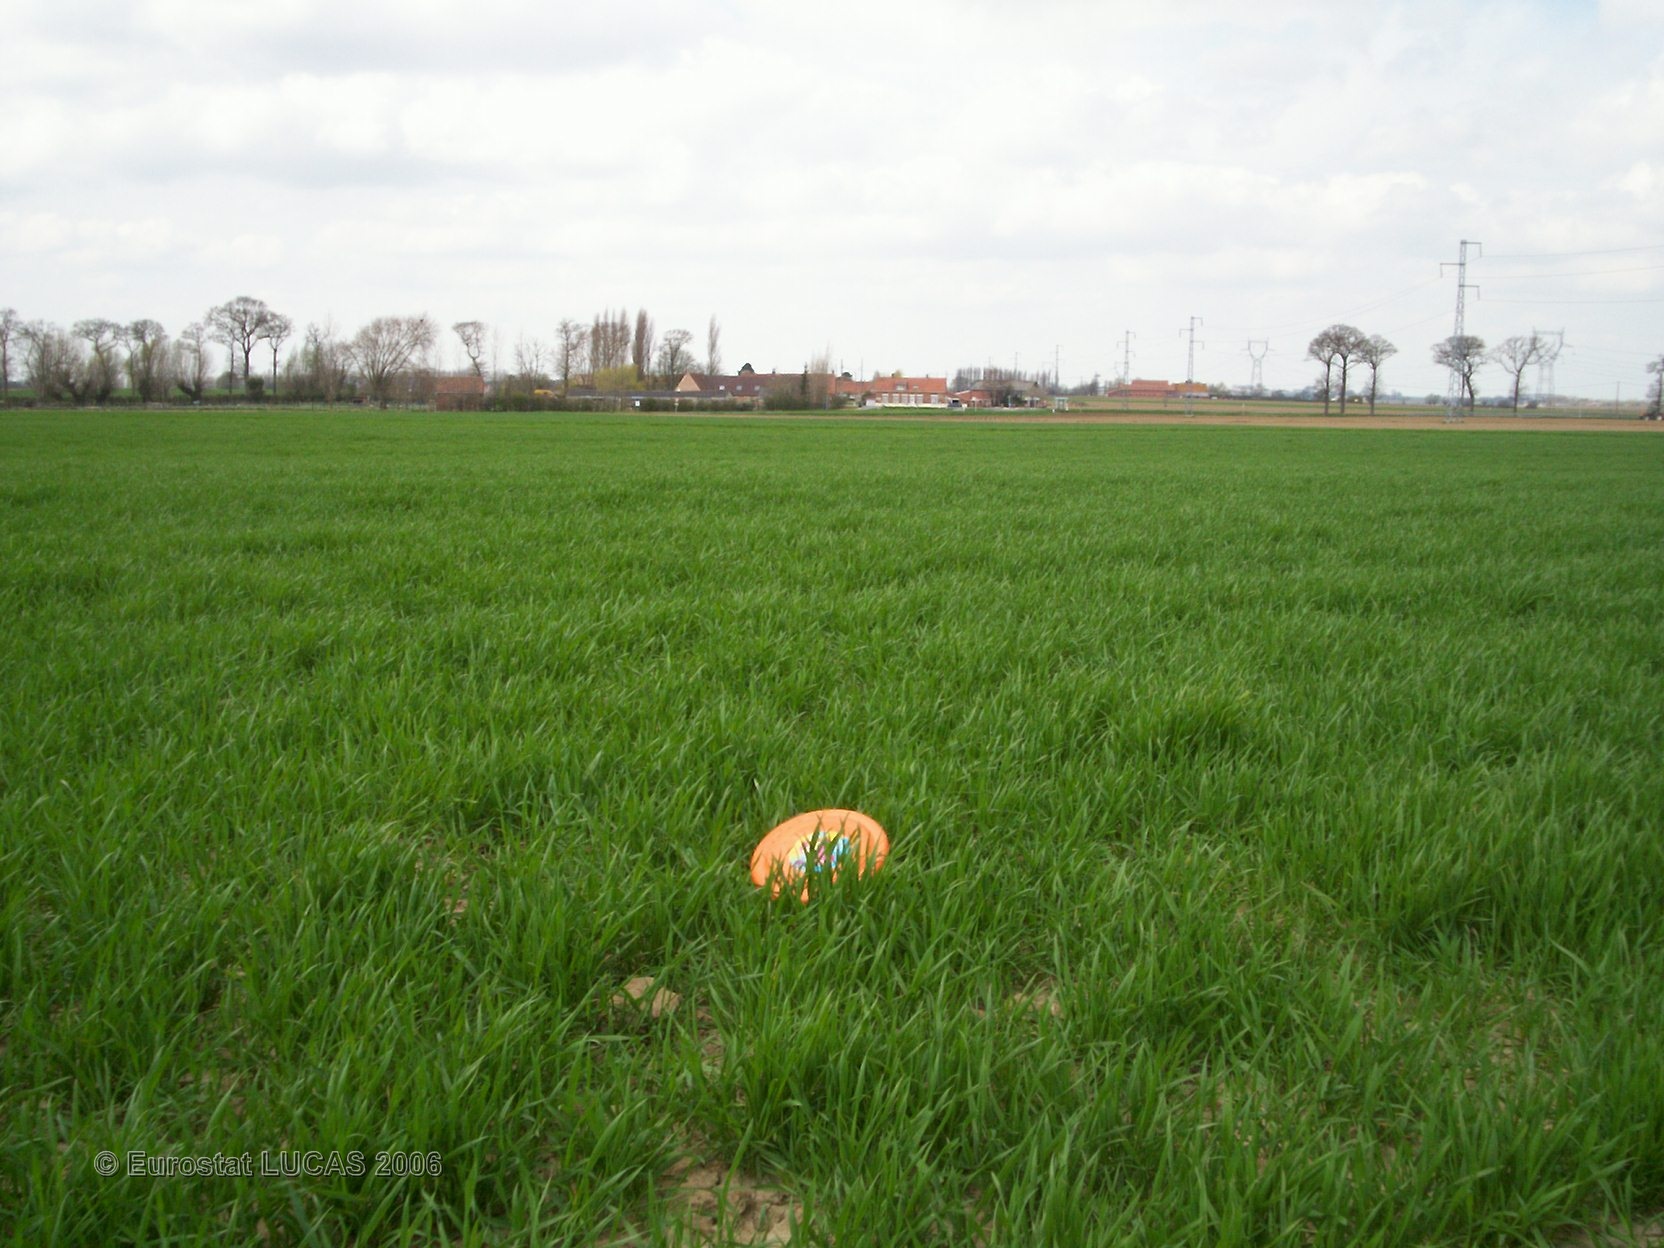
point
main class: Cropland
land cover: Common wheat
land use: Agriculture (excluding fallow land and kitchen gardens)
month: April
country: FR
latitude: 50.7632
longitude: 2.4302
